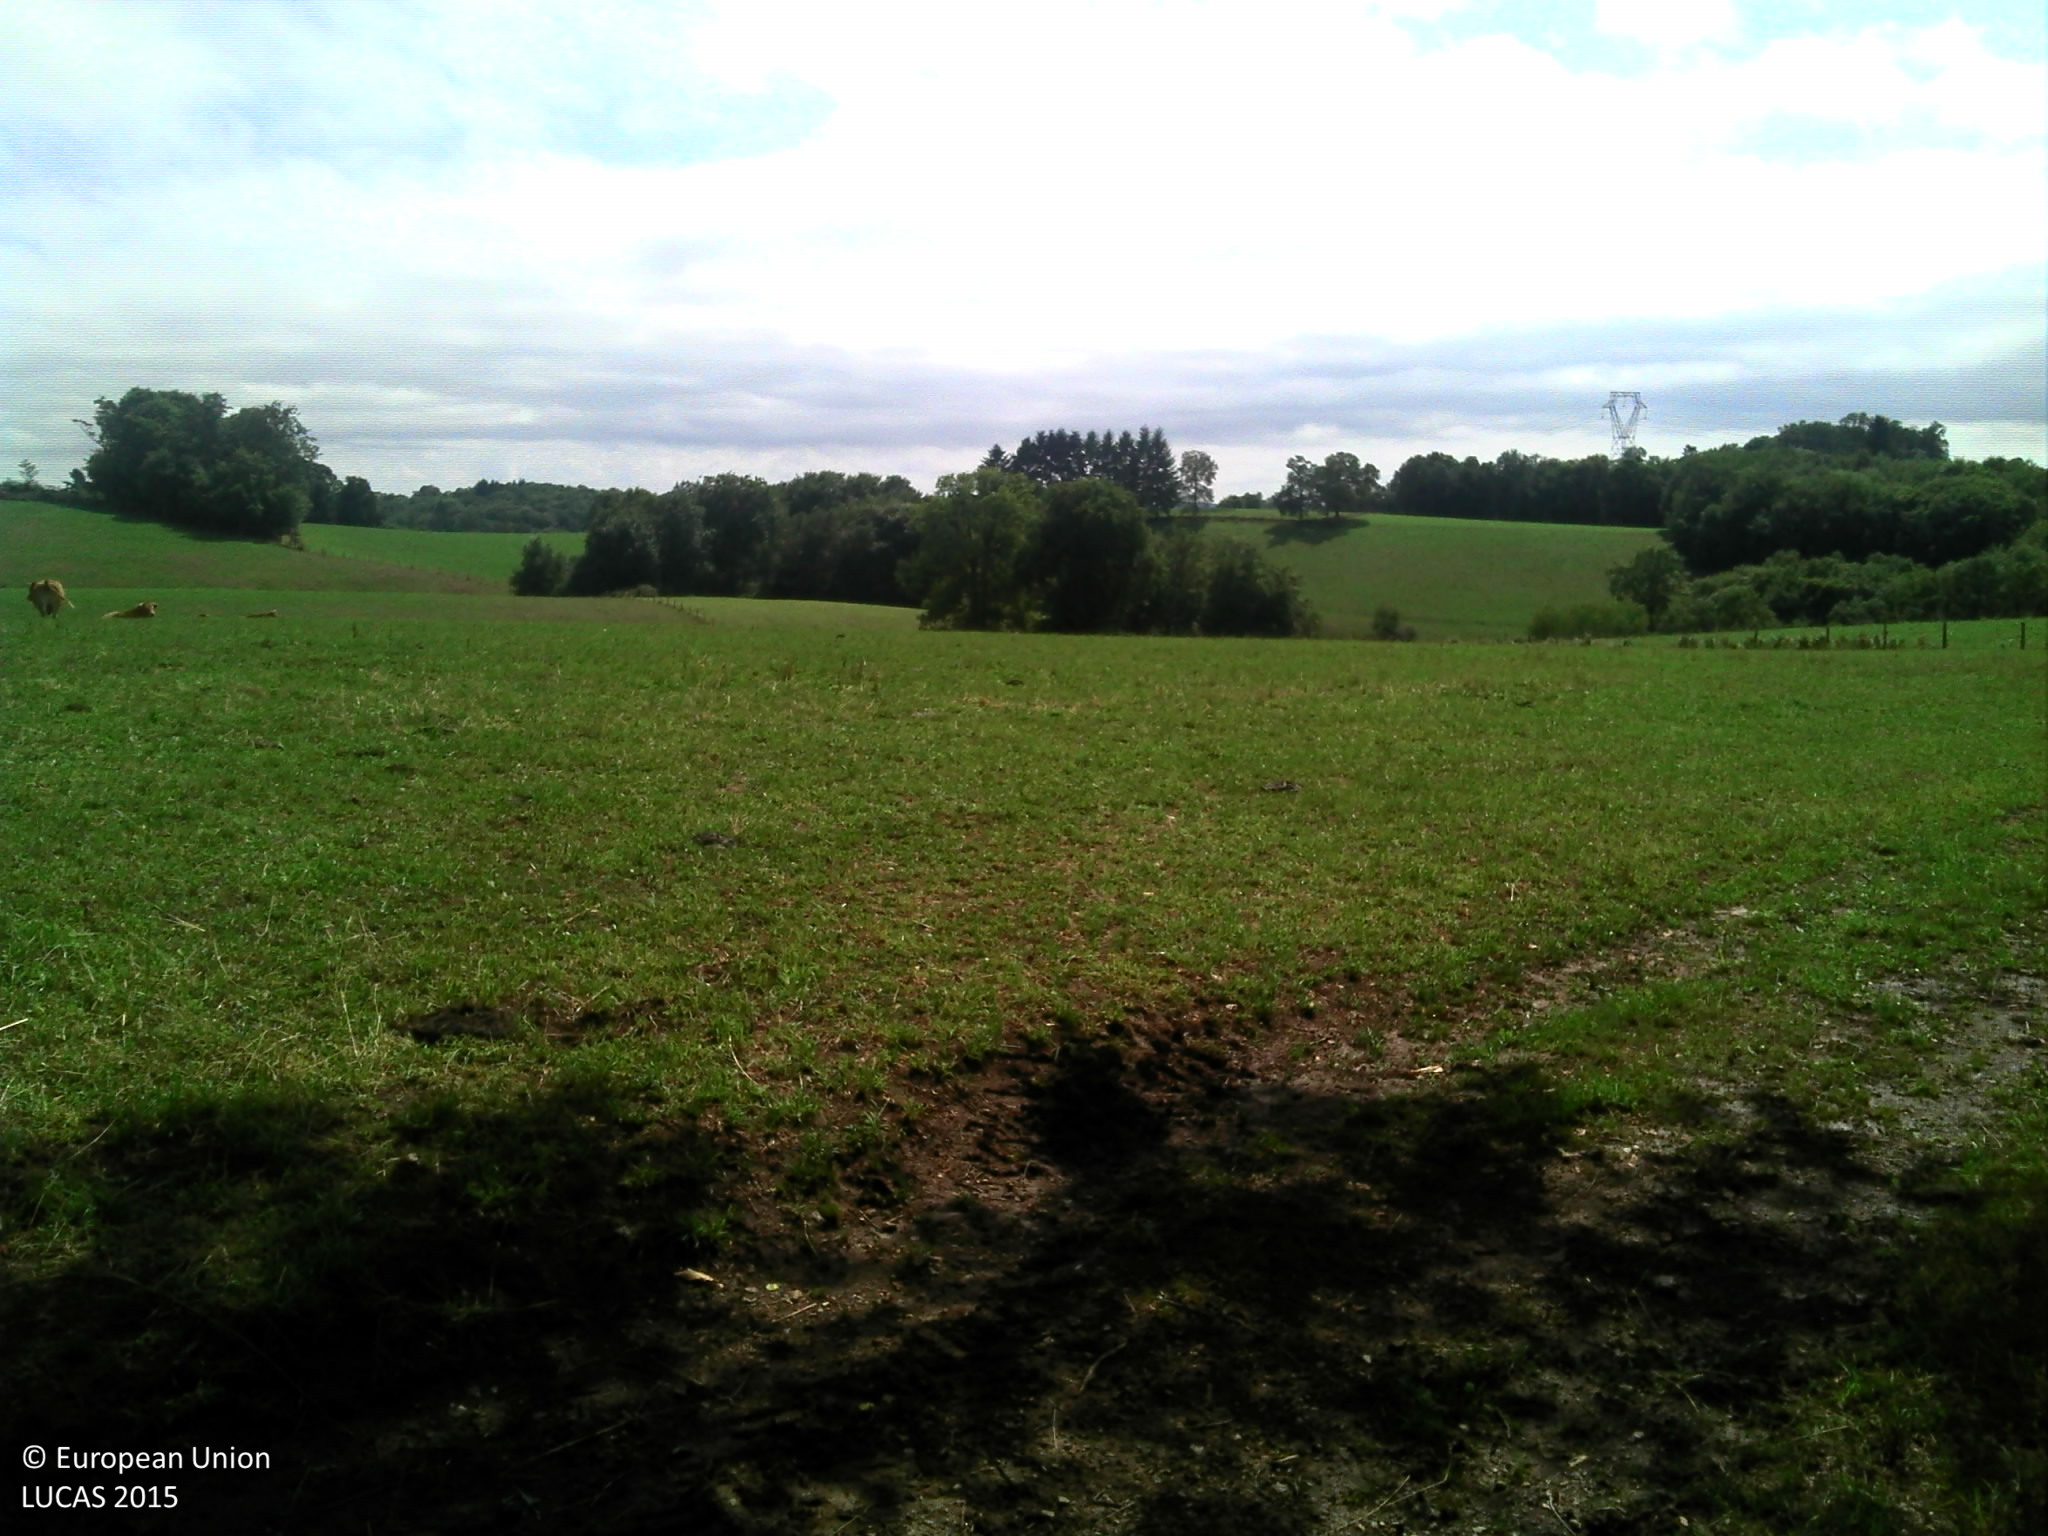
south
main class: Grassland
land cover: Grassland without tree/shrub cover
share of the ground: > 75 %
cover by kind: herbaceous plants 100 %
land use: Agriculture (excluding fallow land and kitchen gardens)
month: August
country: FR
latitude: 45.4546
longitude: 1.7730
